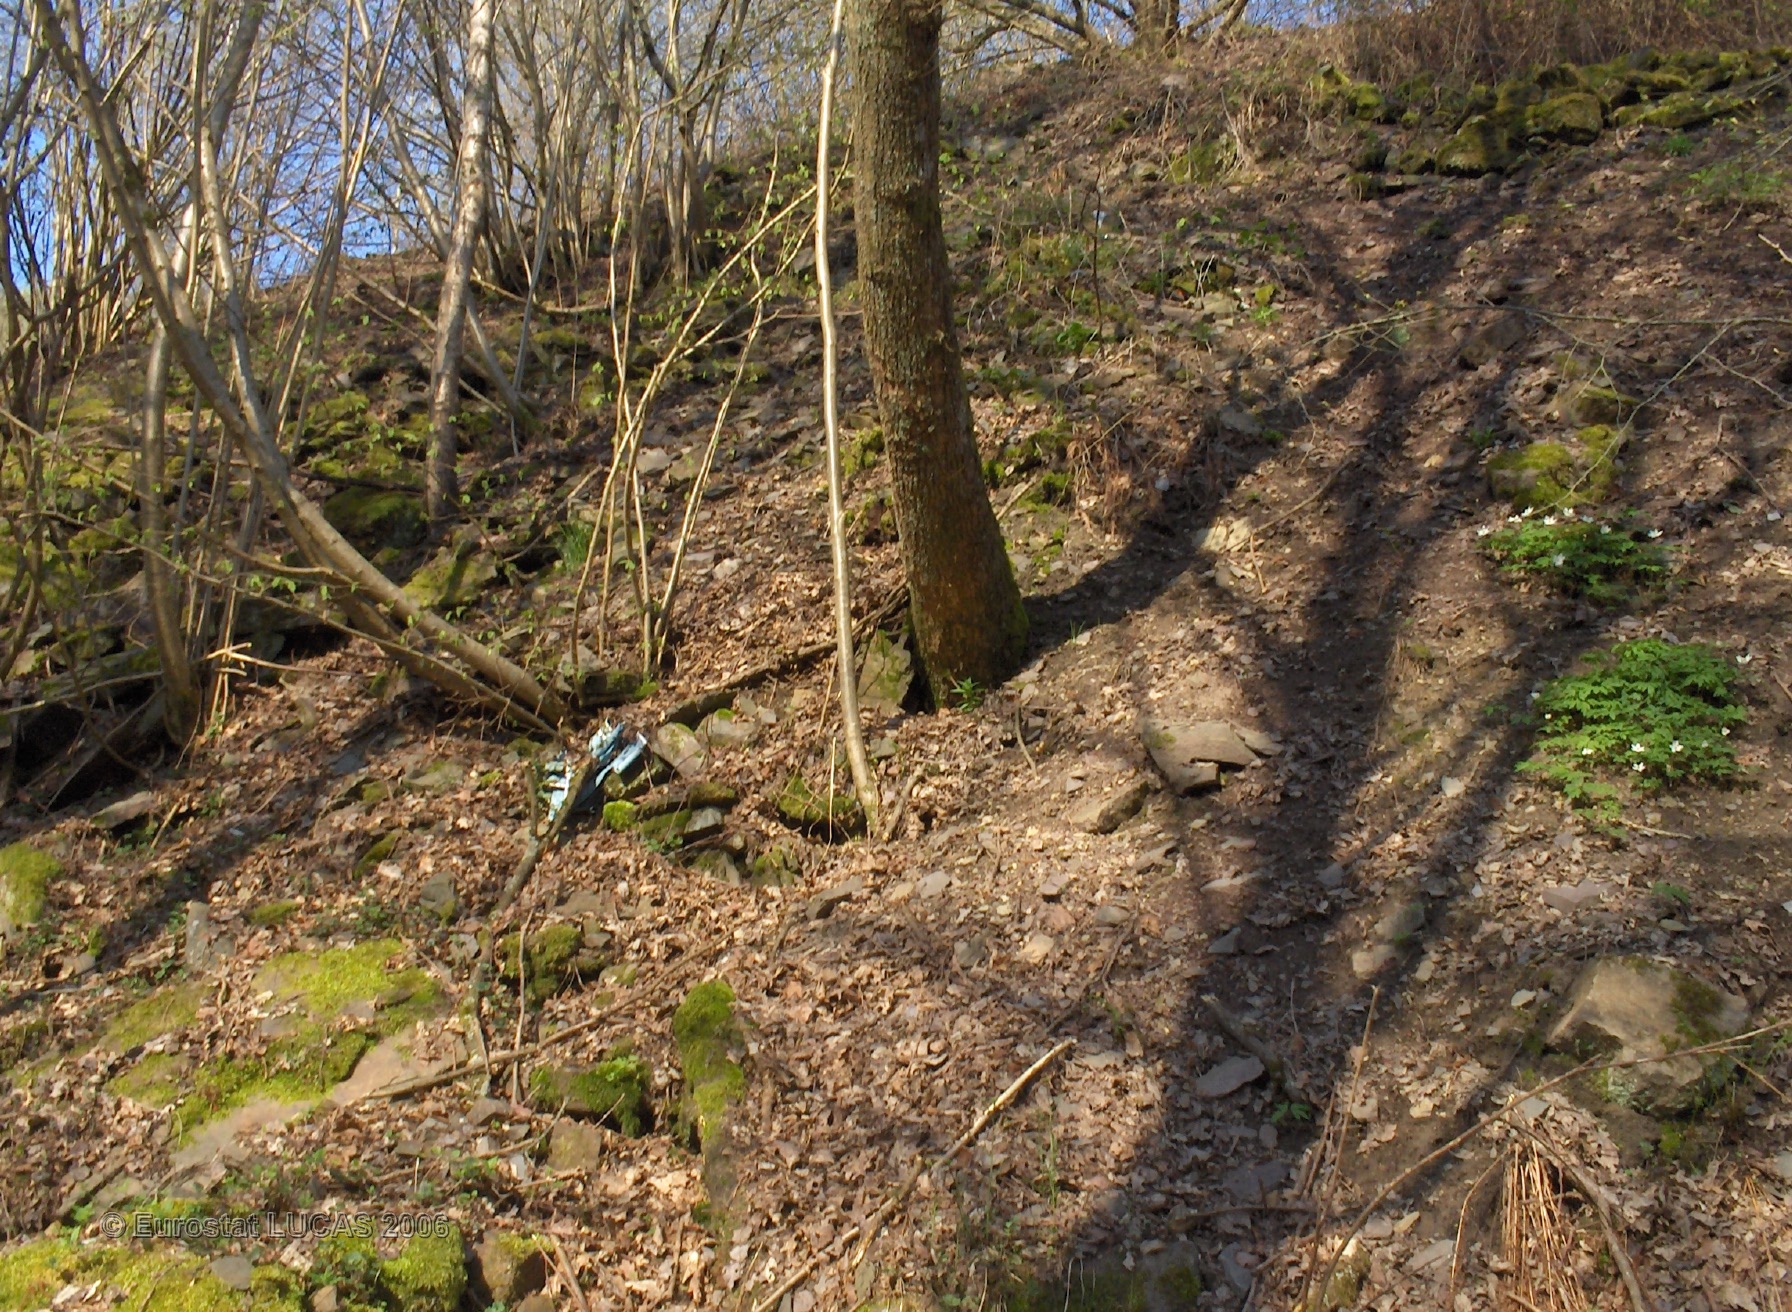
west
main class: Woodland
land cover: Broadleaved forest
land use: Forestry
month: April
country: BE
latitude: 50.0559
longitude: 4.5909
